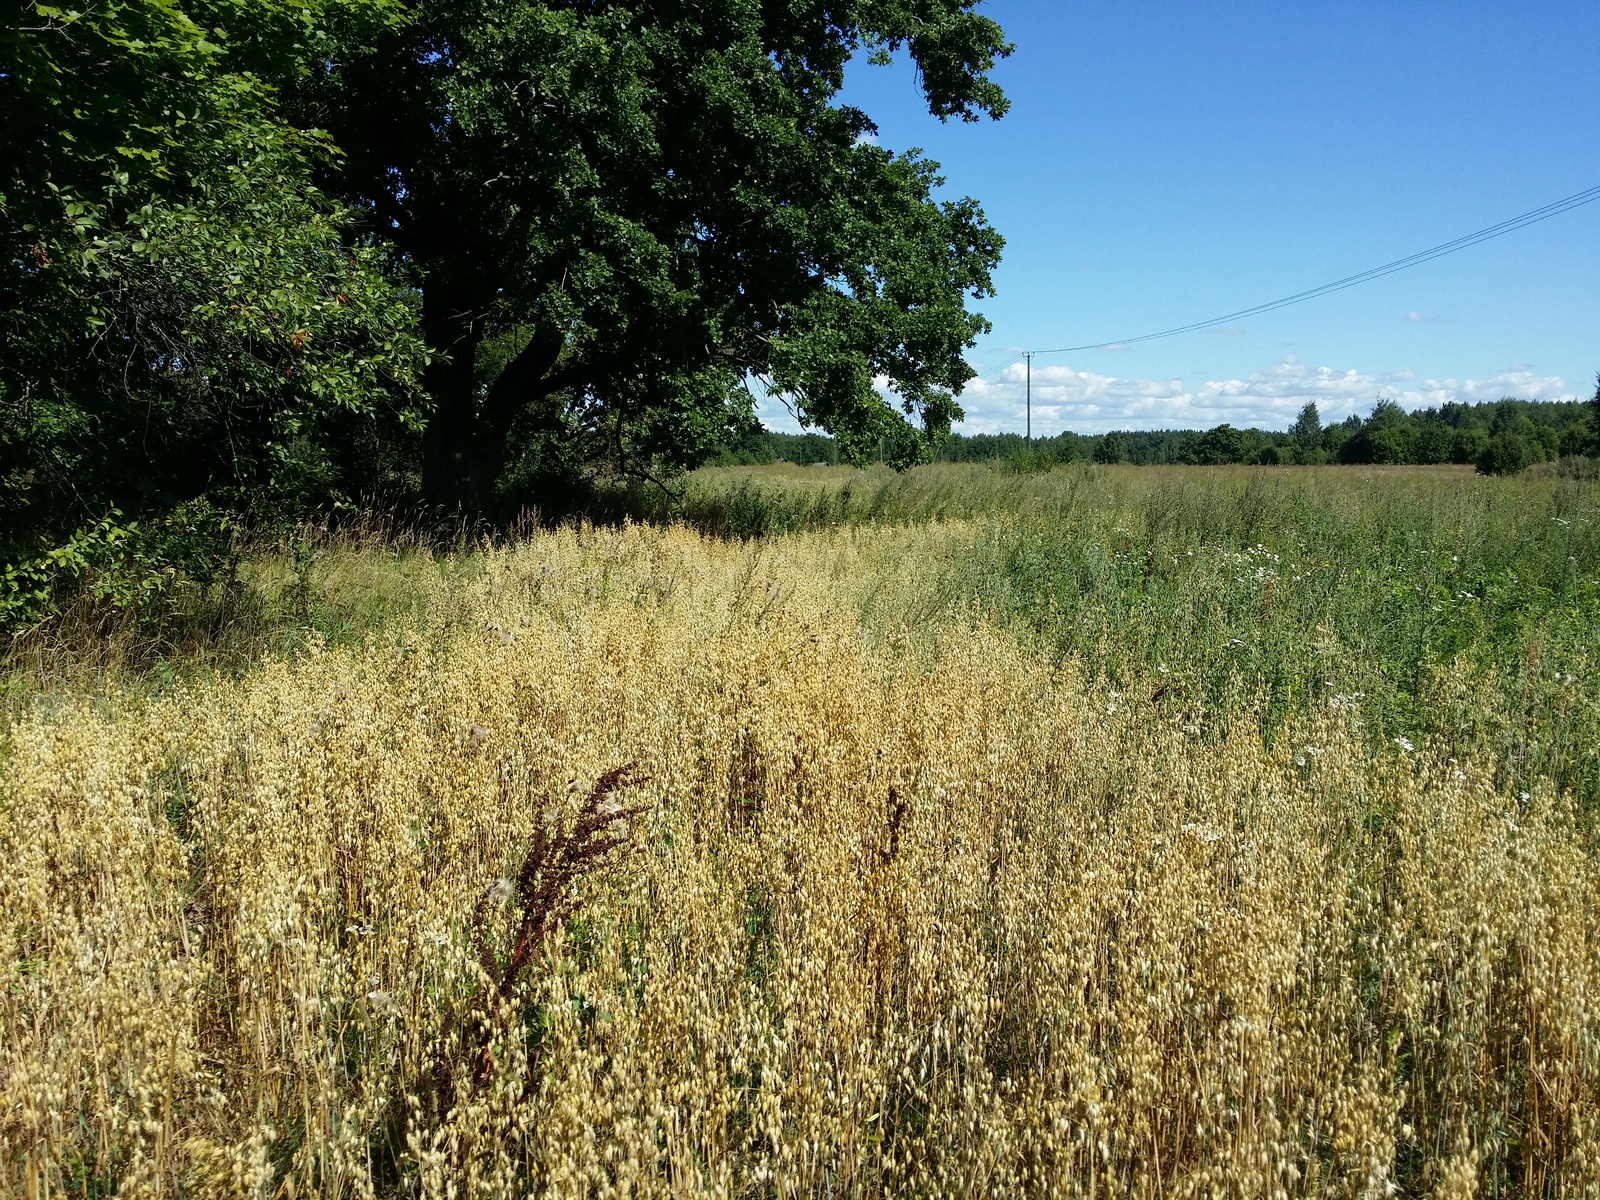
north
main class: Cropland
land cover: Oats
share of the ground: > 75 %
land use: Agriculture (excluding fallow land and kitchen gardens)
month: August
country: LV
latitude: 57.0386
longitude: 27.6331
